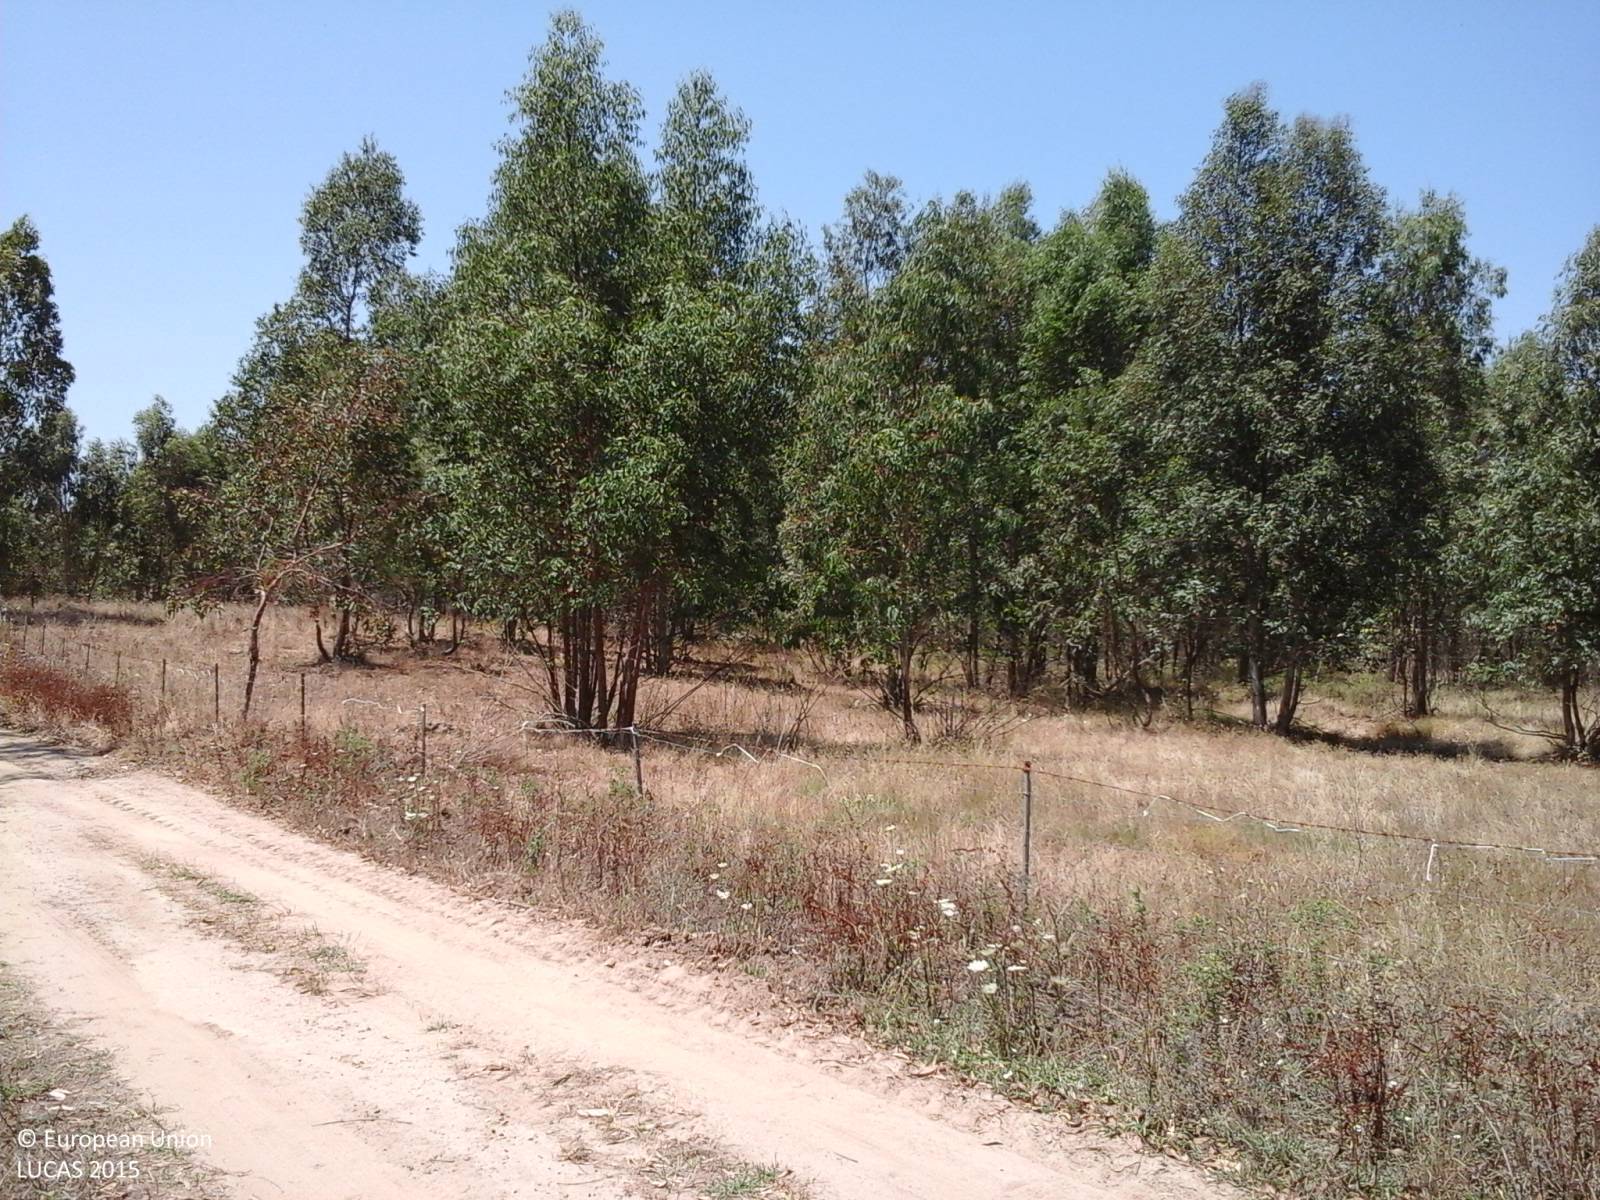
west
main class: Woodland
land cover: Broadleaved woodland
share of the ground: > 75 %
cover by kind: broadleaved forest trees 50 %, unconsolidated bare surface 40 %, herbaceous plants 10 %
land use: Agriculture (excluding fallow land and kitchen gardens)
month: June
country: IT
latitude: 39.8619
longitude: 8.8259
